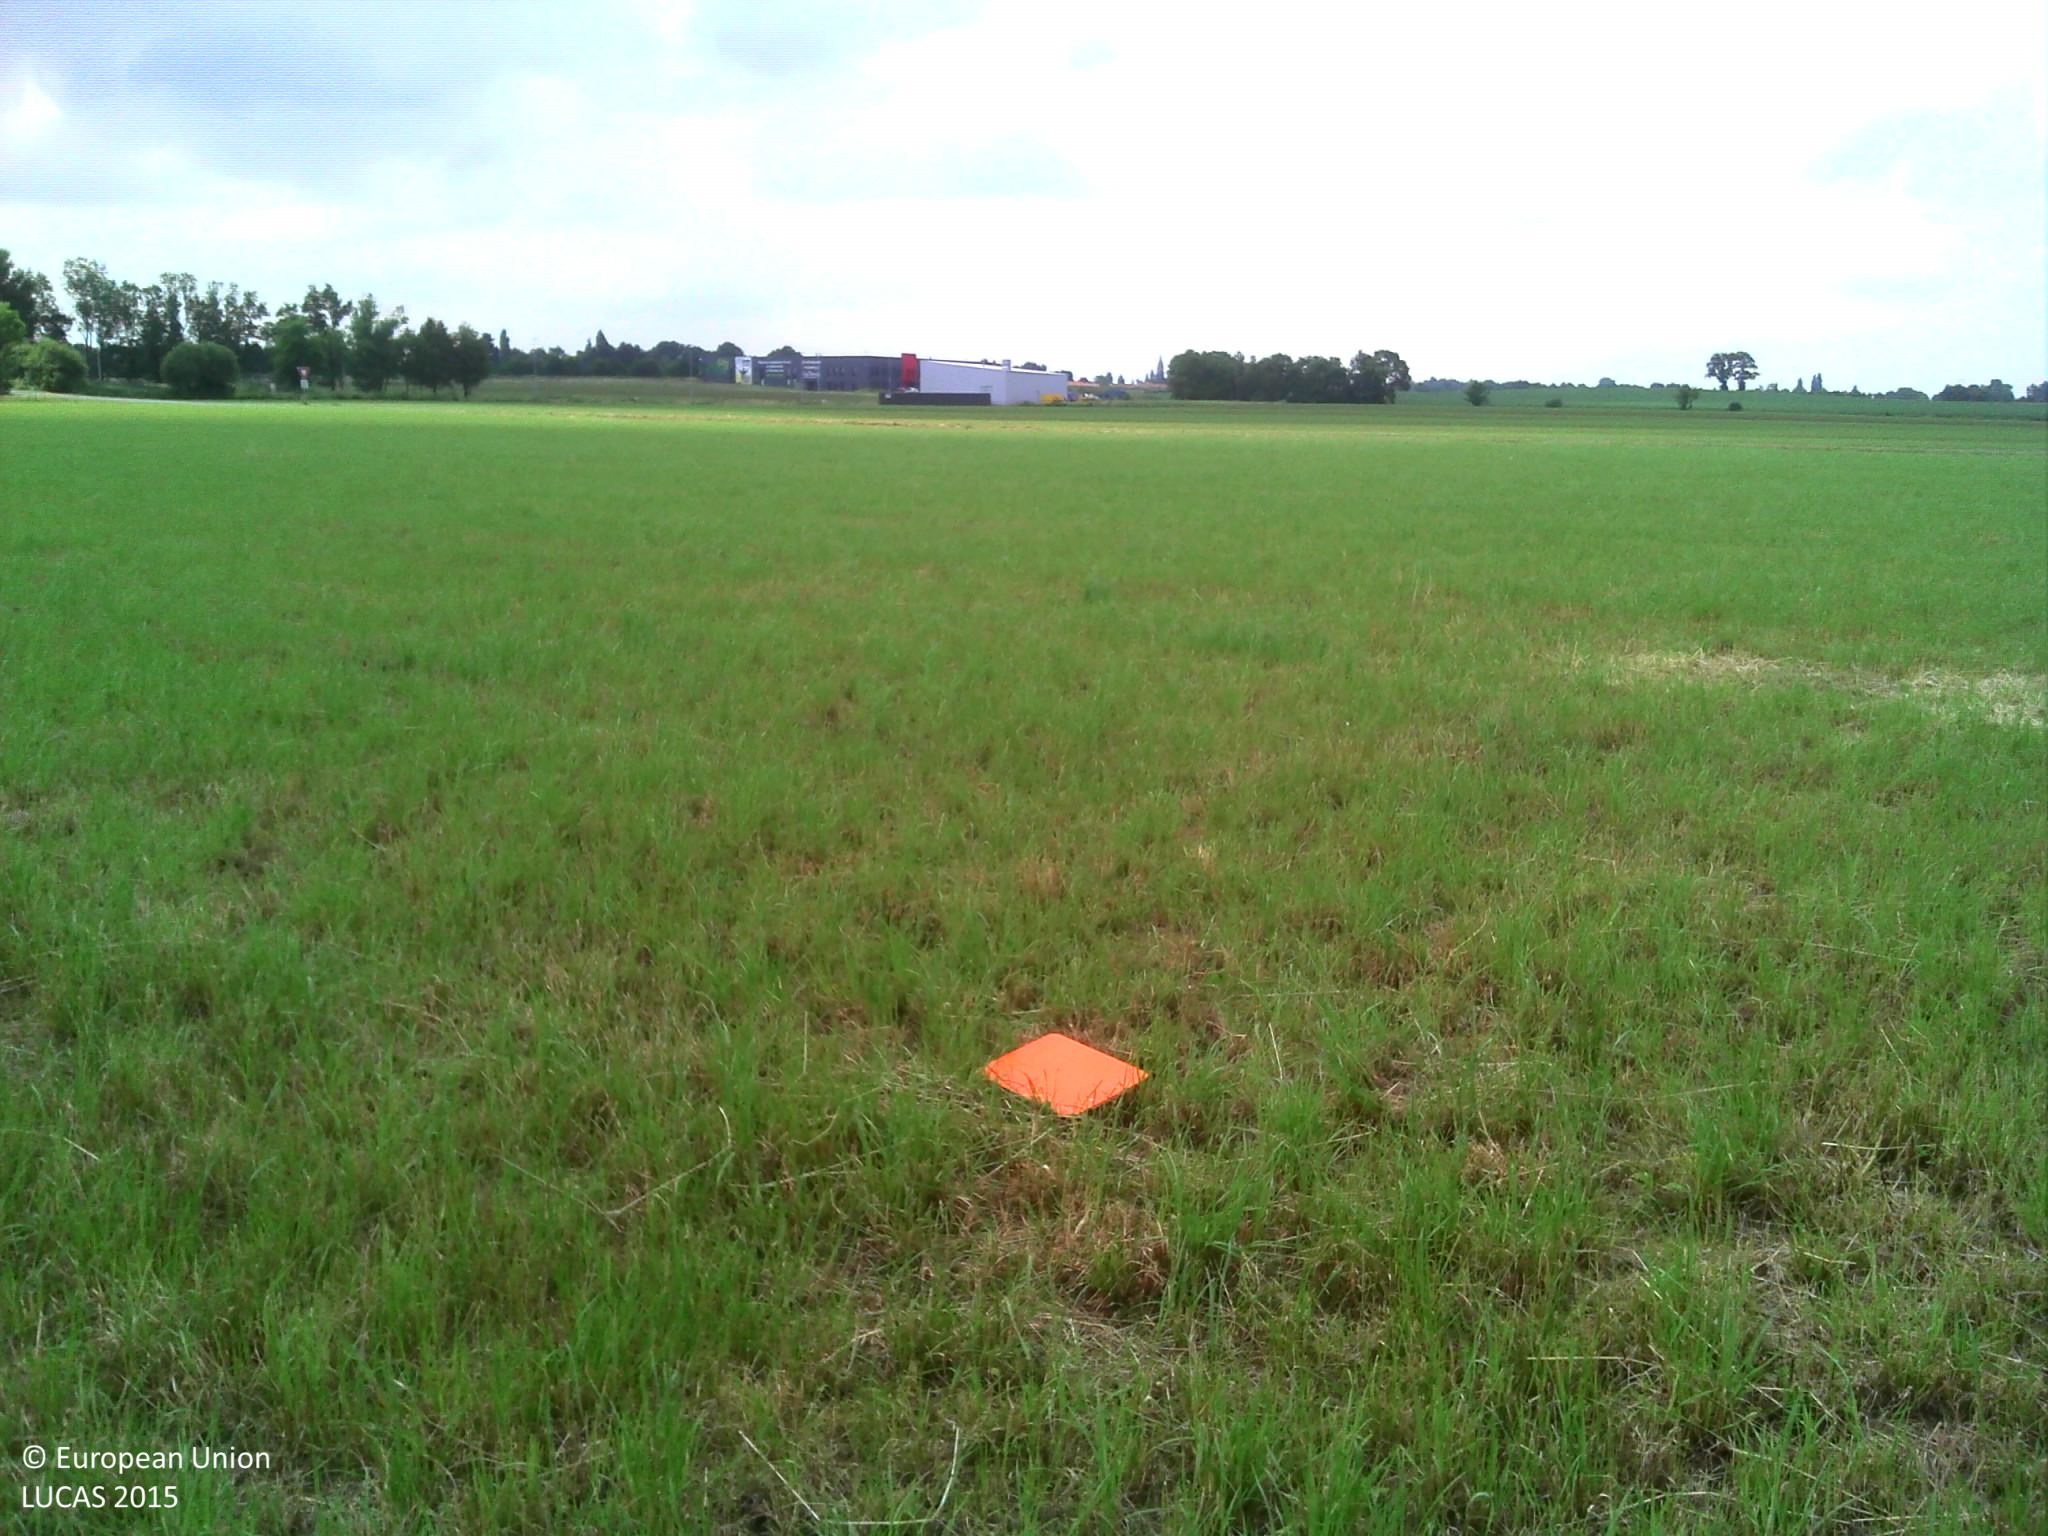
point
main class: Cropland
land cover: Temporary grasslands
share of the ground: > 75 %
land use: Agriculture (excluding fallow land and kitchen gardens)
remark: Harvested field
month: June
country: FR
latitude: 46.9243
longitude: -1.3718
